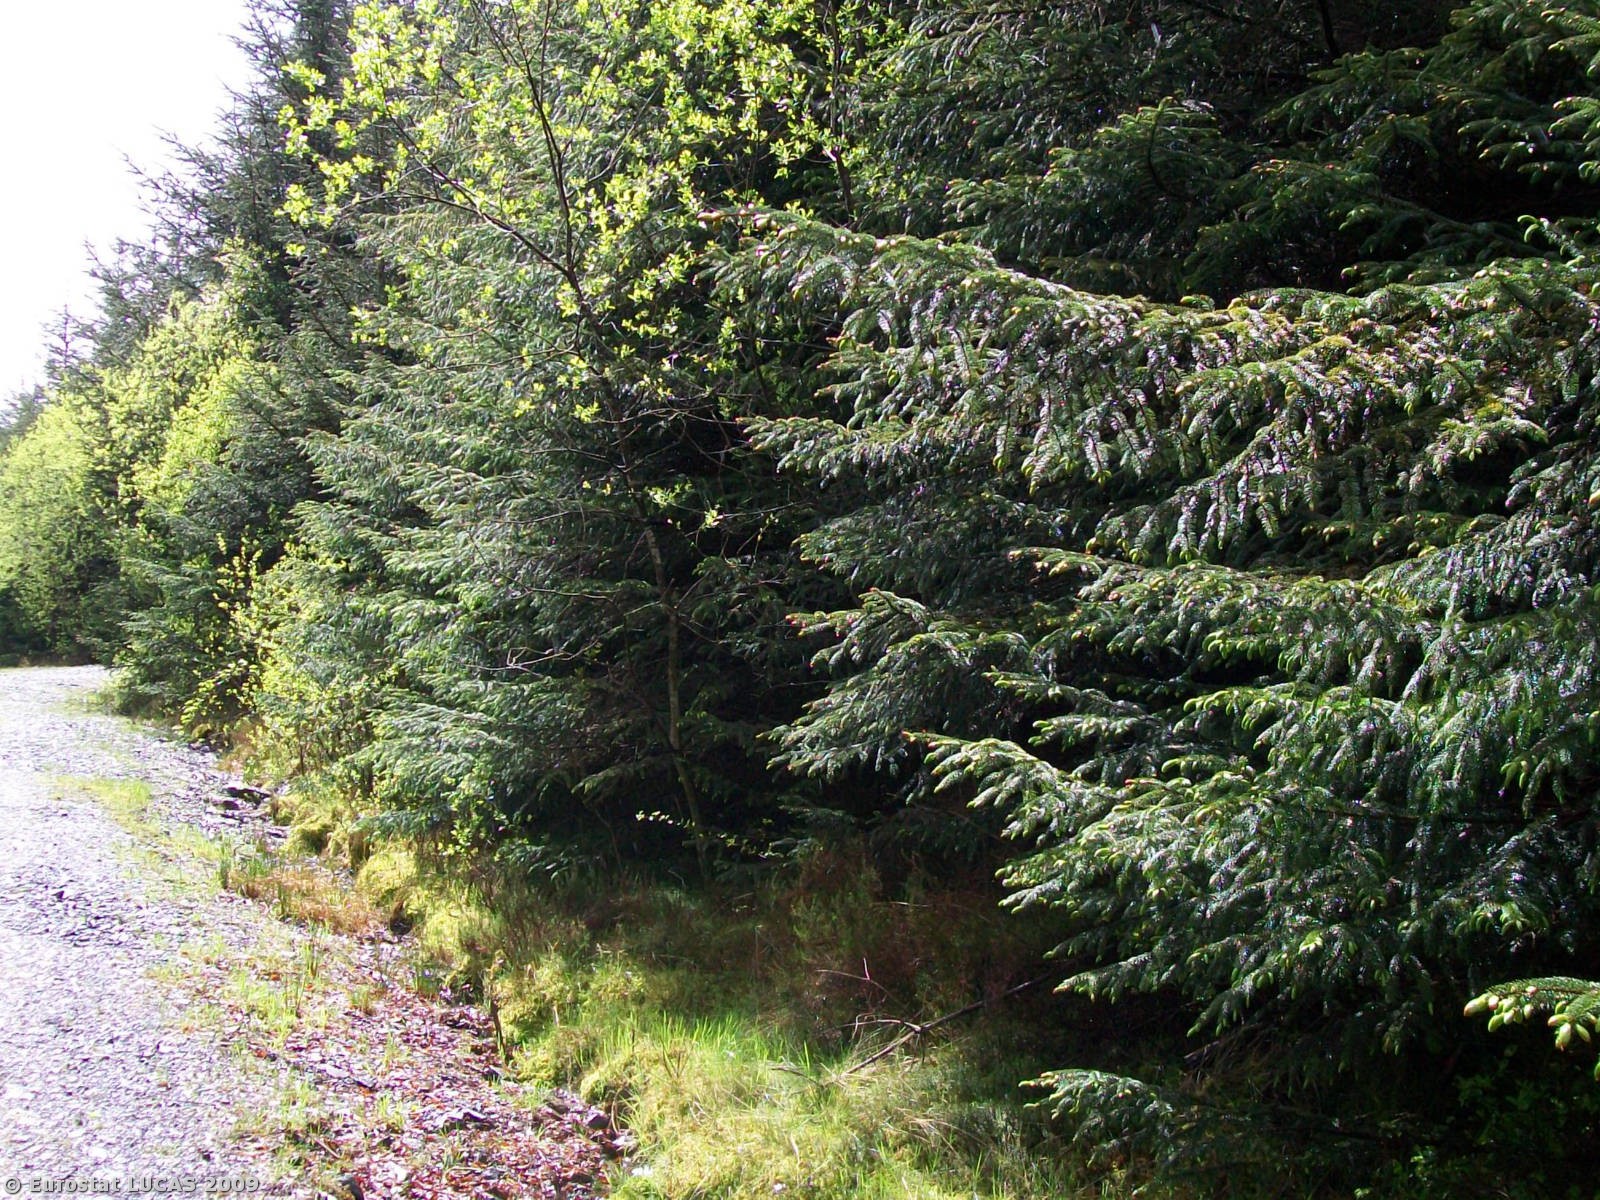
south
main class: Woodland
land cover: Coniferous woodland
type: plantations and self-sown exotic forest
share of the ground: > 75 %
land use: Forestry
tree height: > 5 m
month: May
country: GB
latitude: 51.9090
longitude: -3.6795
